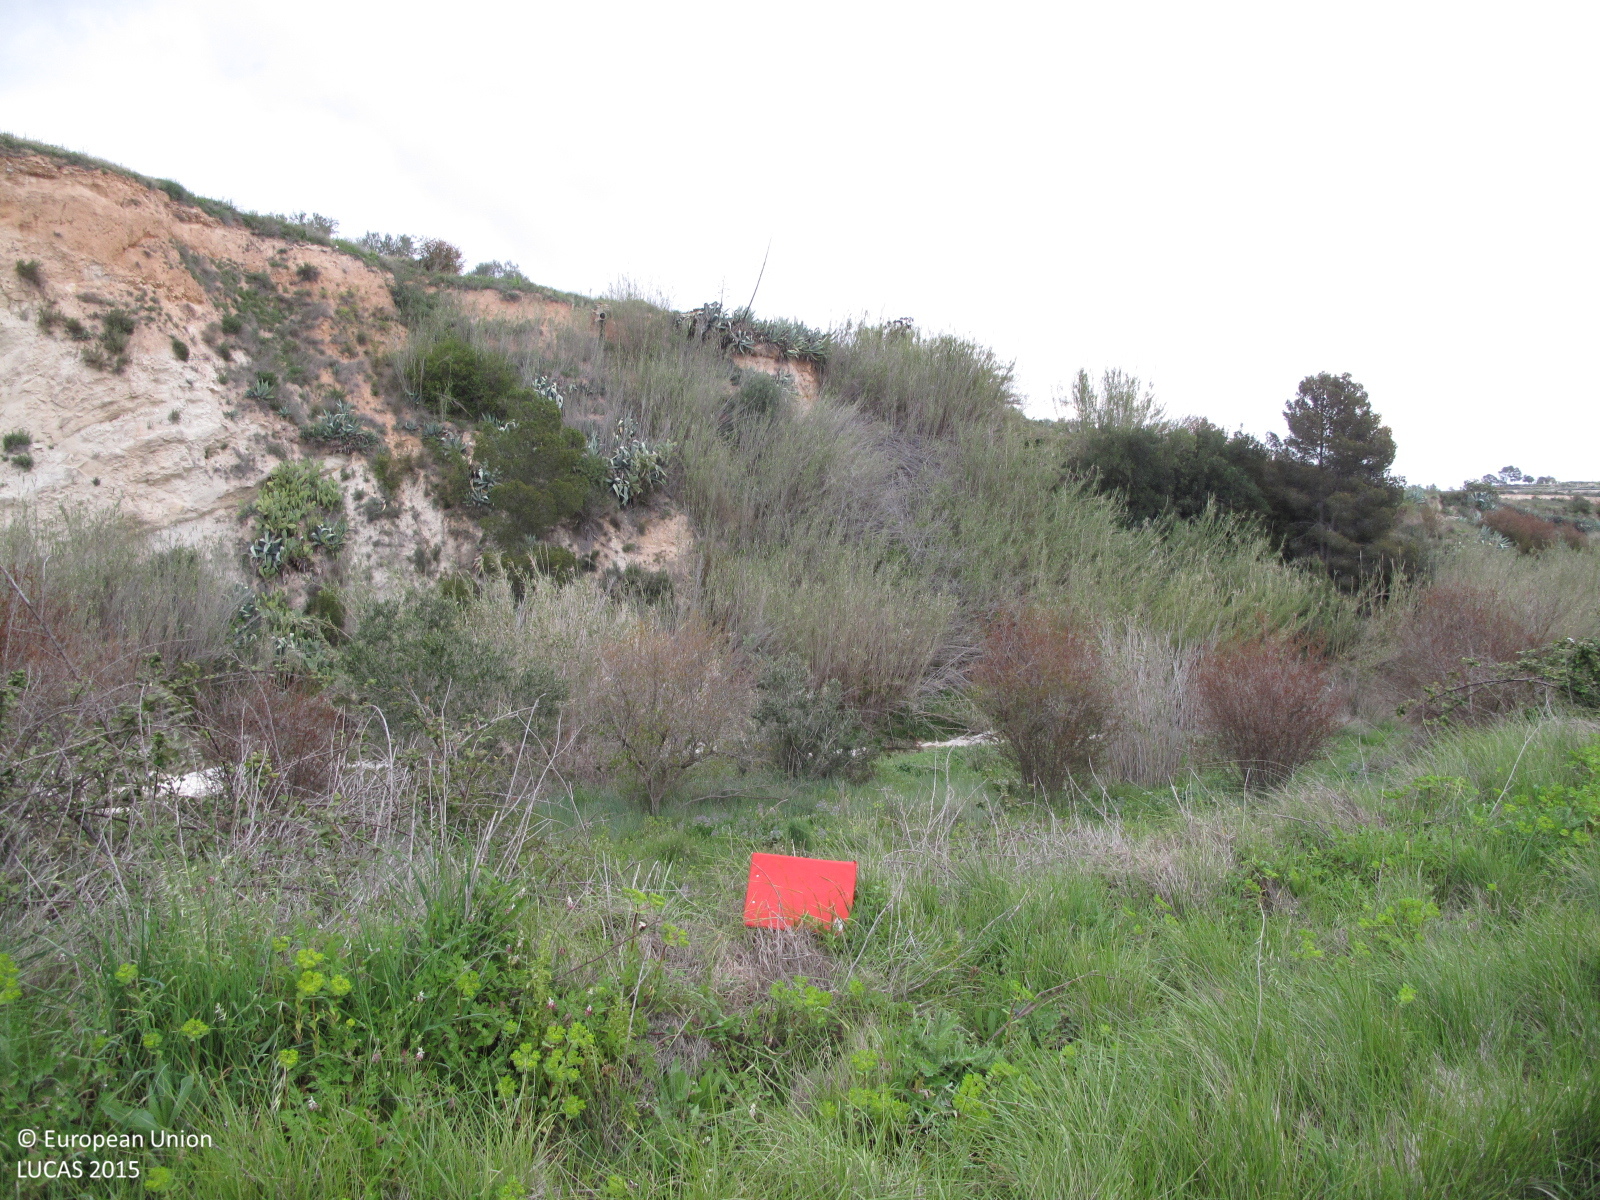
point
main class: Grassland
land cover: Grassland with sparse tree/shrub cover
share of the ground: > 75 %
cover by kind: herbaceous plants 90 %, broadleaved forest trees 5 %, shrubs 5 %
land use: Semi-natural and natural areas not in use
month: April
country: ES
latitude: 38.8722
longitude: -0.5841
